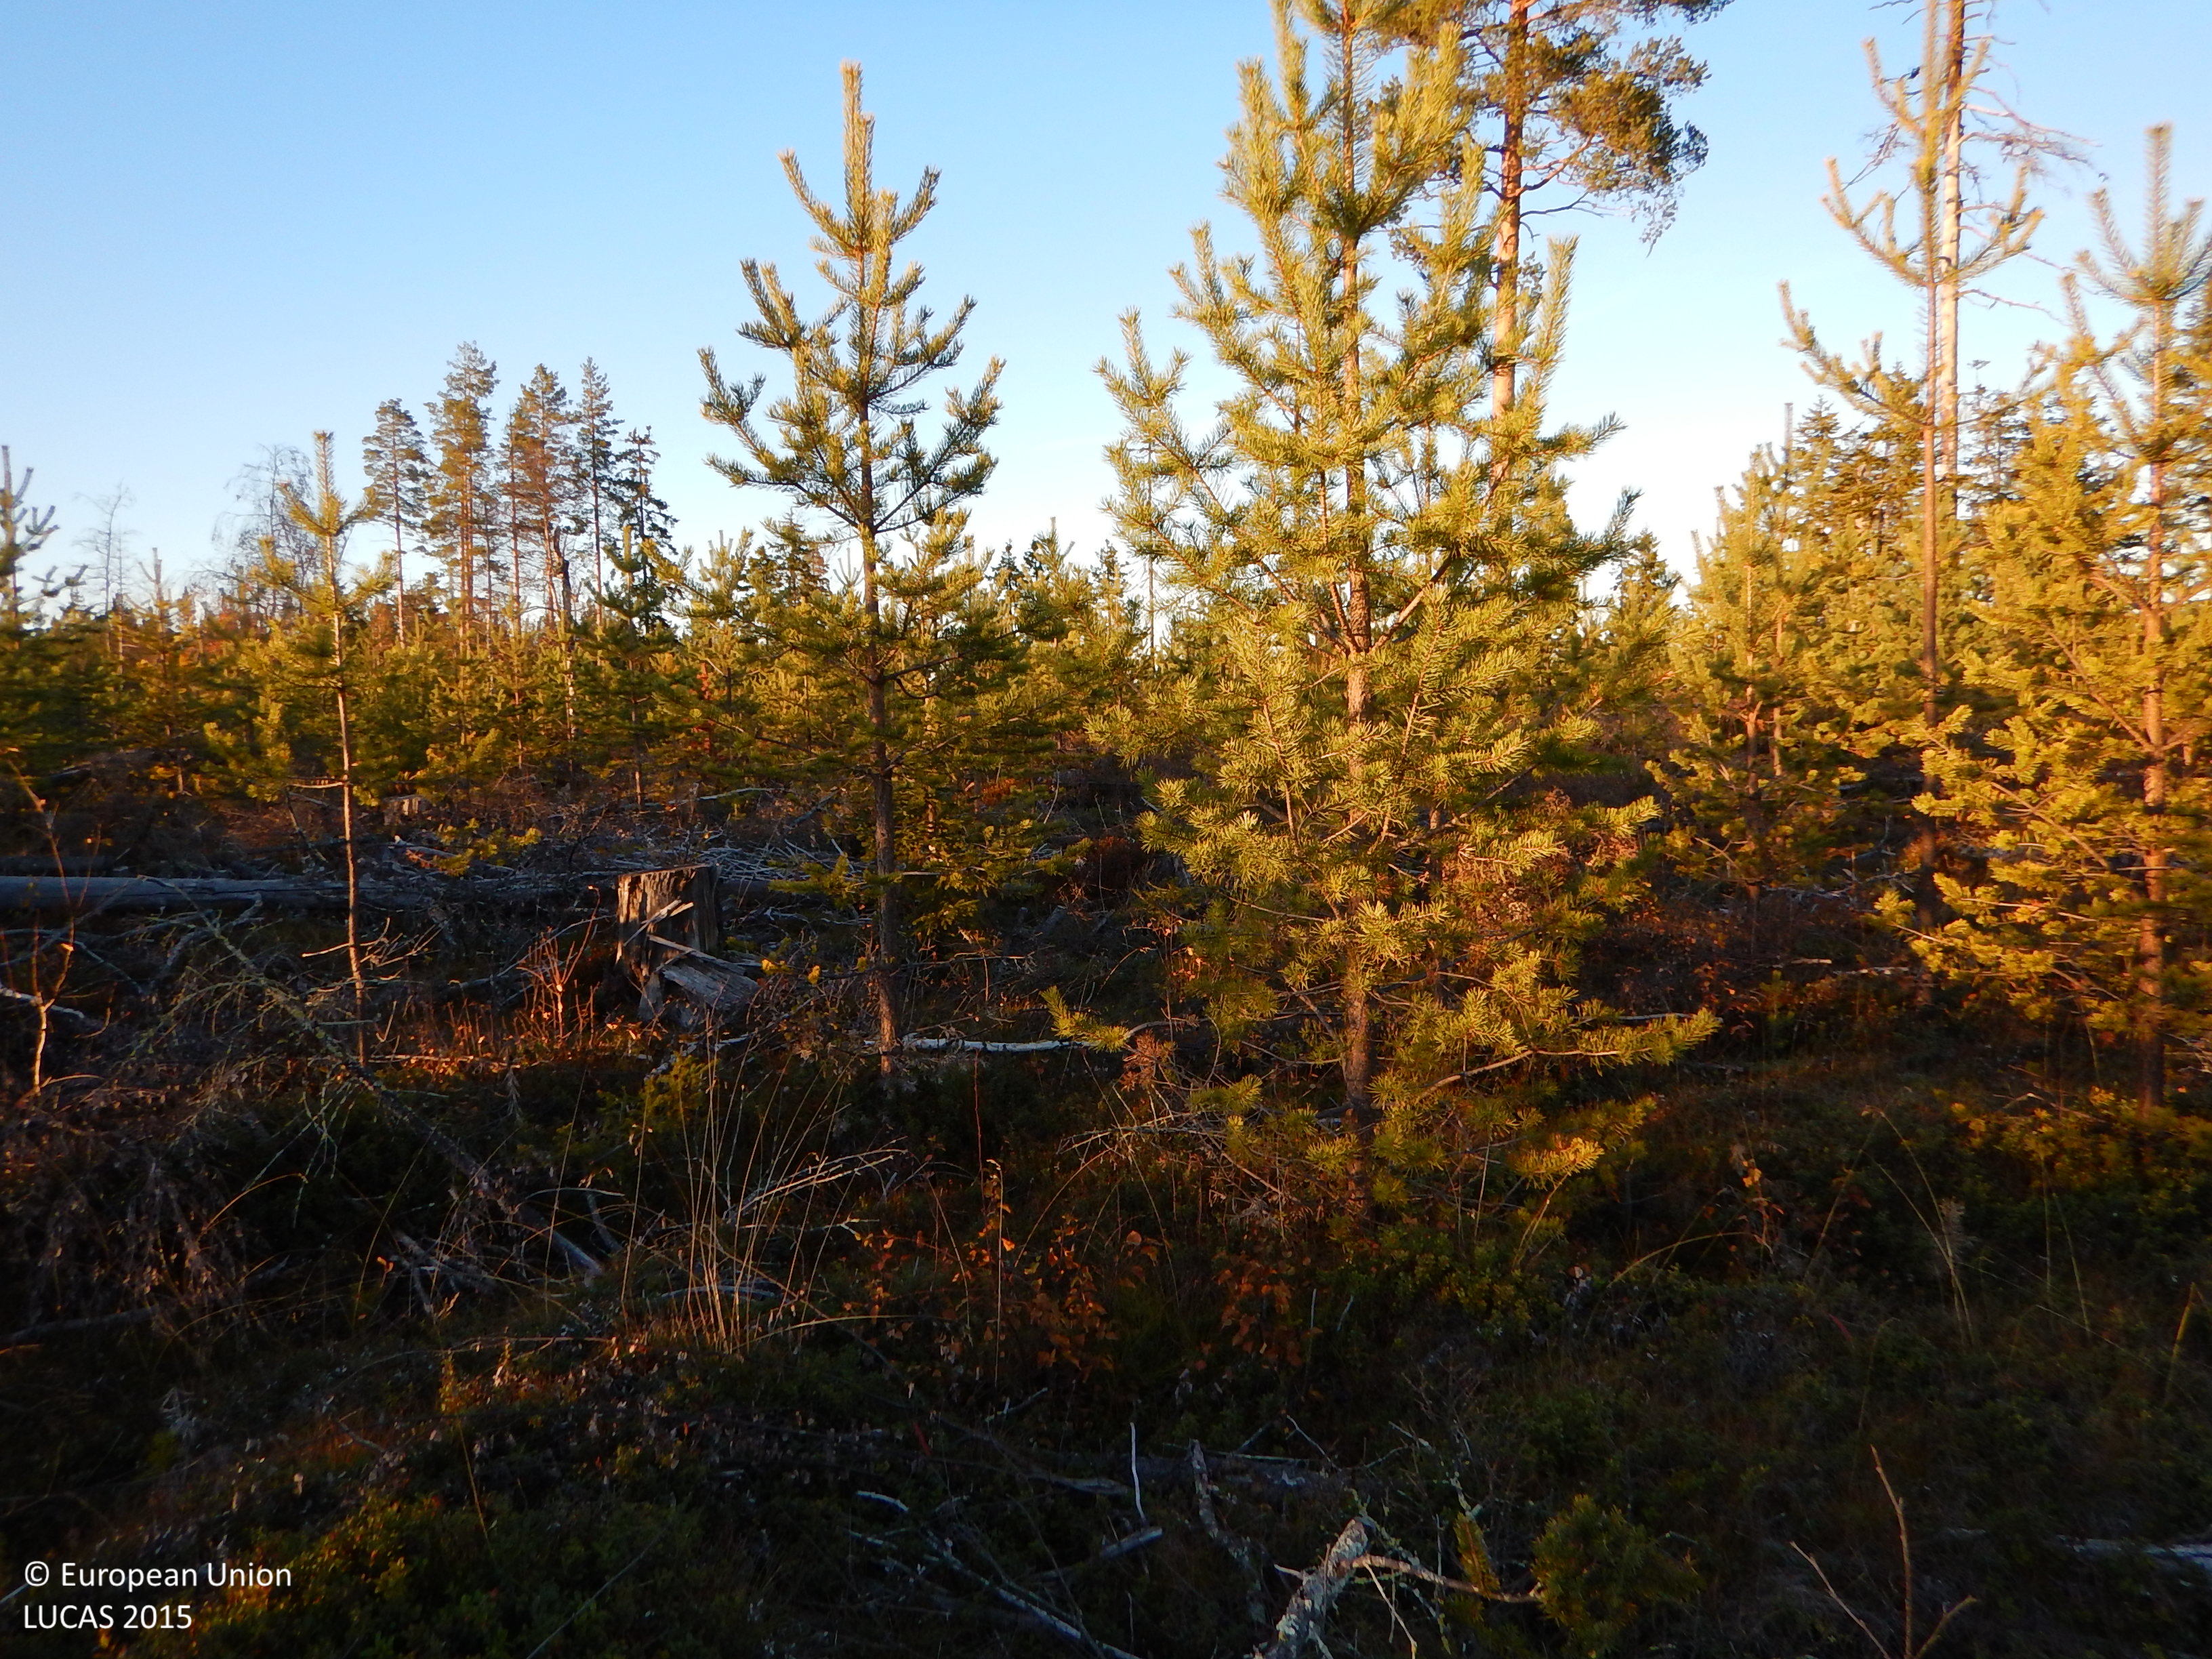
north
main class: Woodland
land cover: Pine dominated coniferous woodland
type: boreal forest
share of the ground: 50 - 75 %
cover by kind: coniferous forest trees 60 %, shrubs 15 %, lichens and mosses 15 %, broadleaved forest trees 5 %, herbaceous plants 5 %
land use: Forestry
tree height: < 5 m
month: October
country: SE
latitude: 65.1209
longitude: 20.8592
